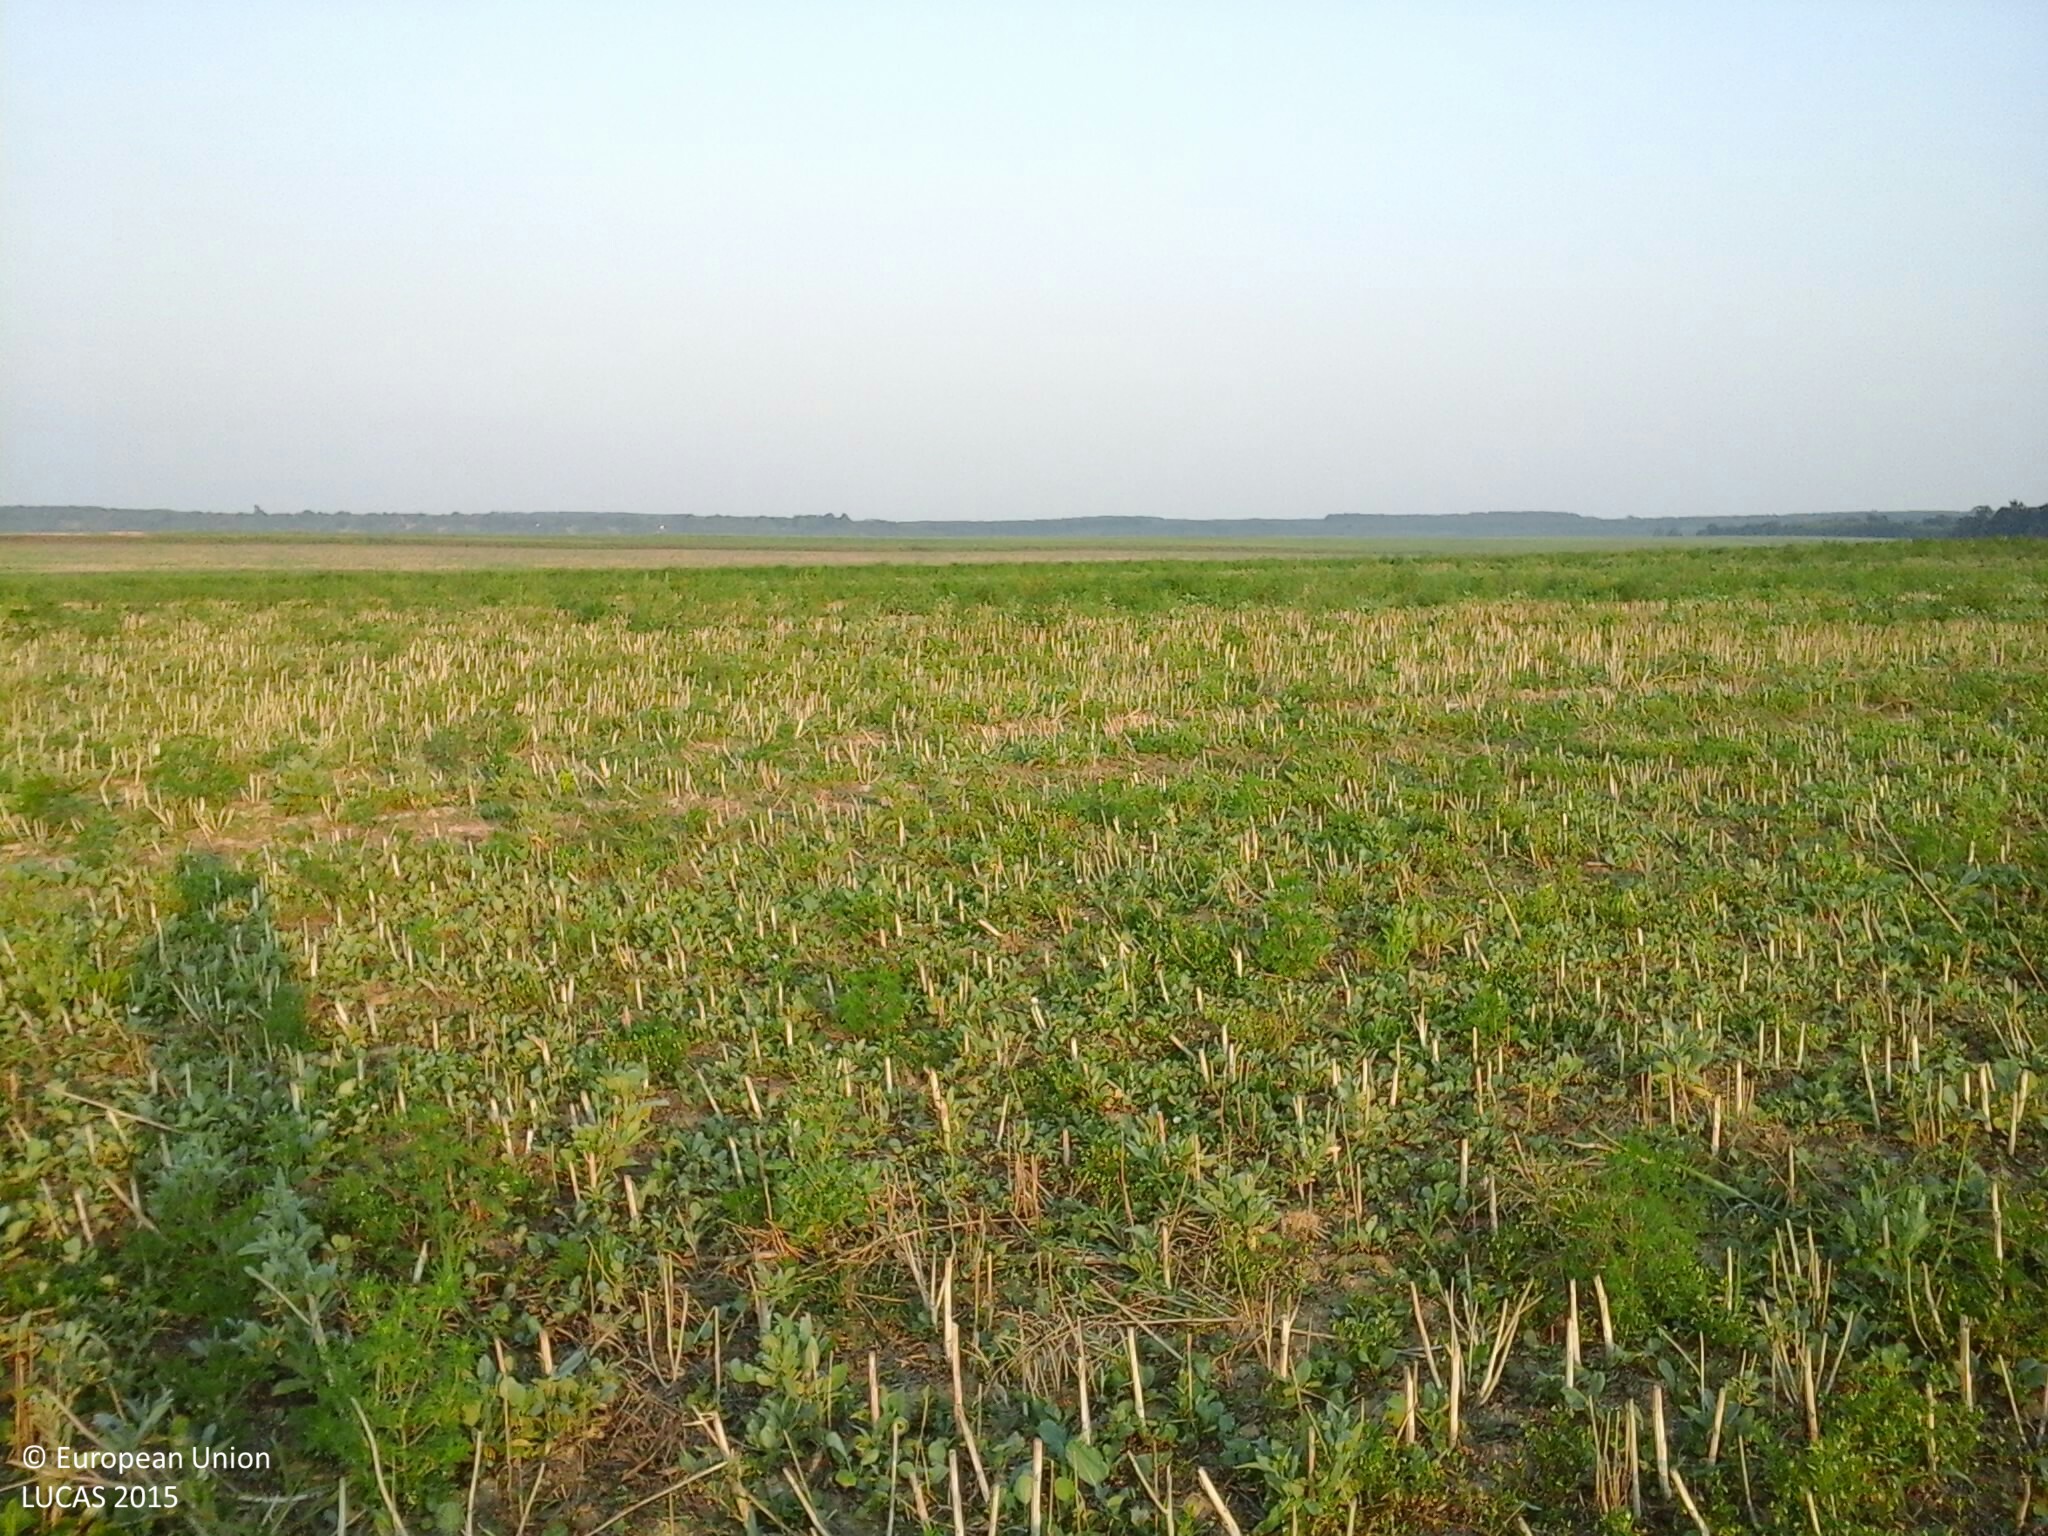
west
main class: Cropland
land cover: Rape and turnip rape
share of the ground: < 10 %
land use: Agriculture (excluding fallow land and kitchen gardens)
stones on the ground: < 10 %
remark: Harvested field
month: August
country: HU
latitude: 47.1139
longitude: 17.0293
